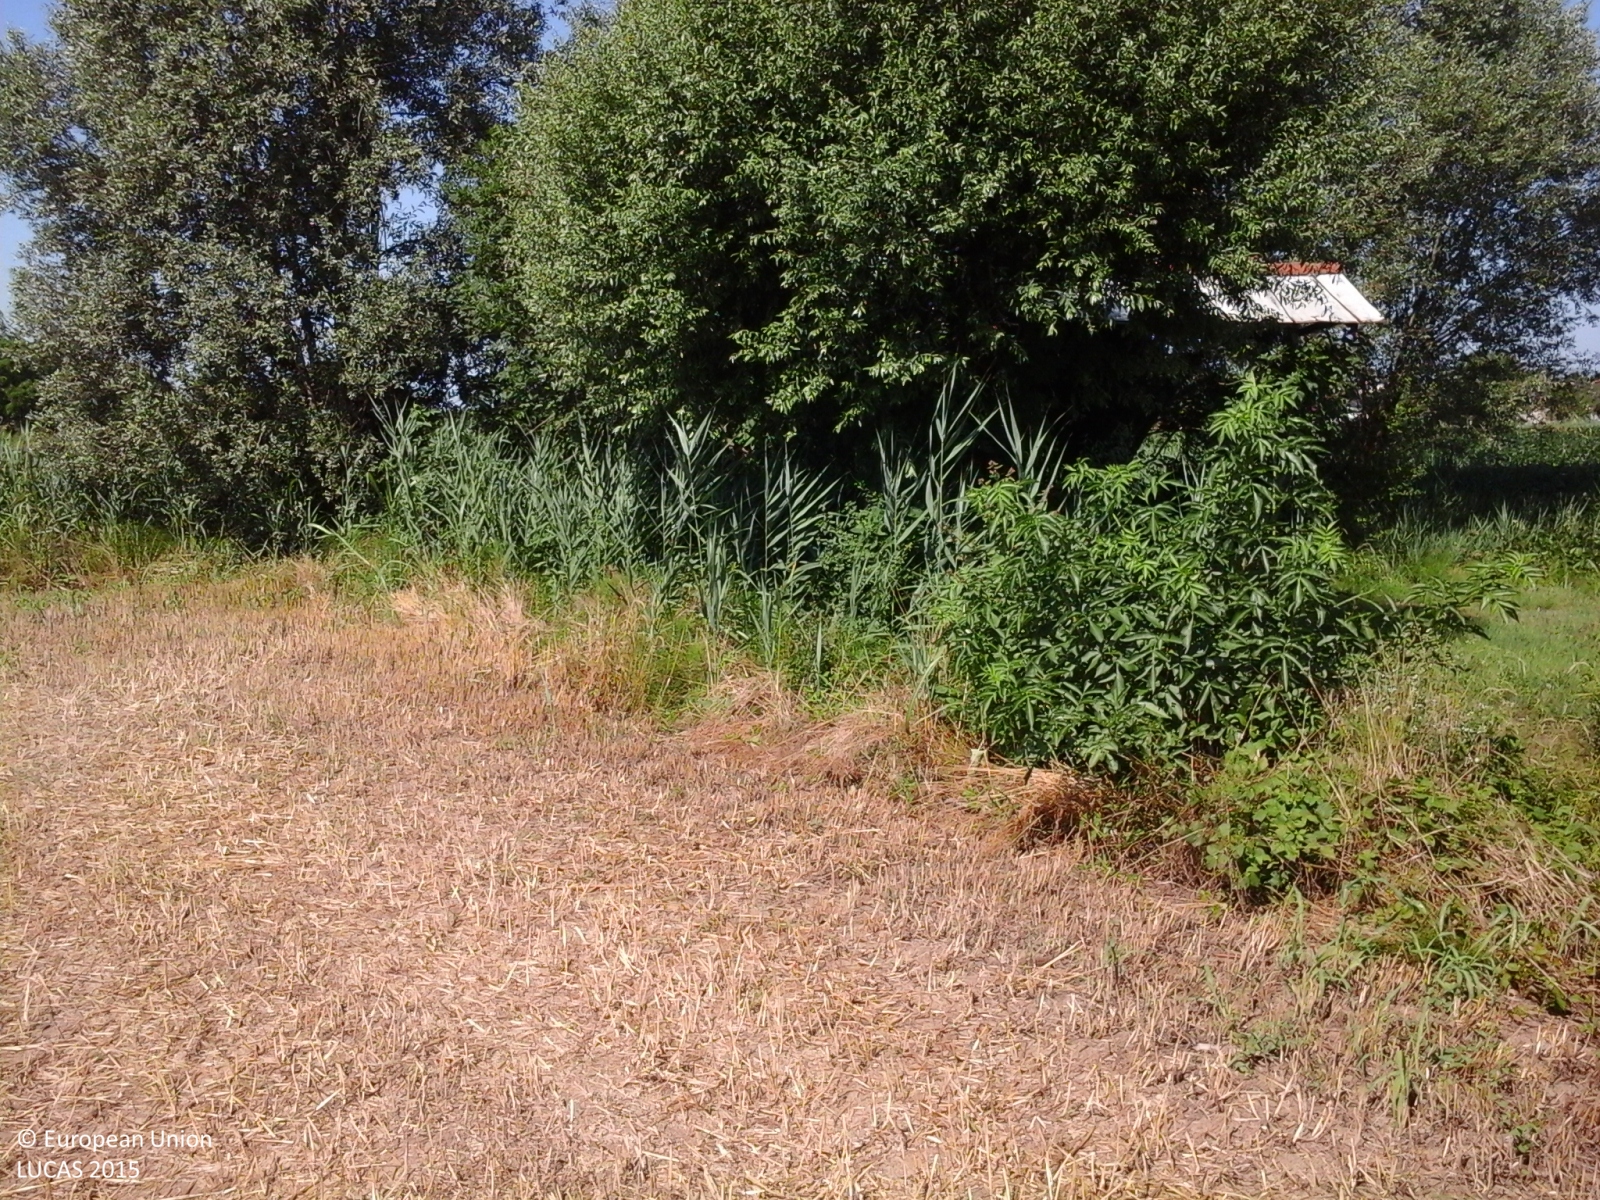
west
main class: Cropland
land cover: Common wheat
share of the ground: > 75 %
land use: Agriculture (excluding fallow land and kitchen gardens)
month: July
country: IT
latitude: 45.6947
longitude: 12.3467
